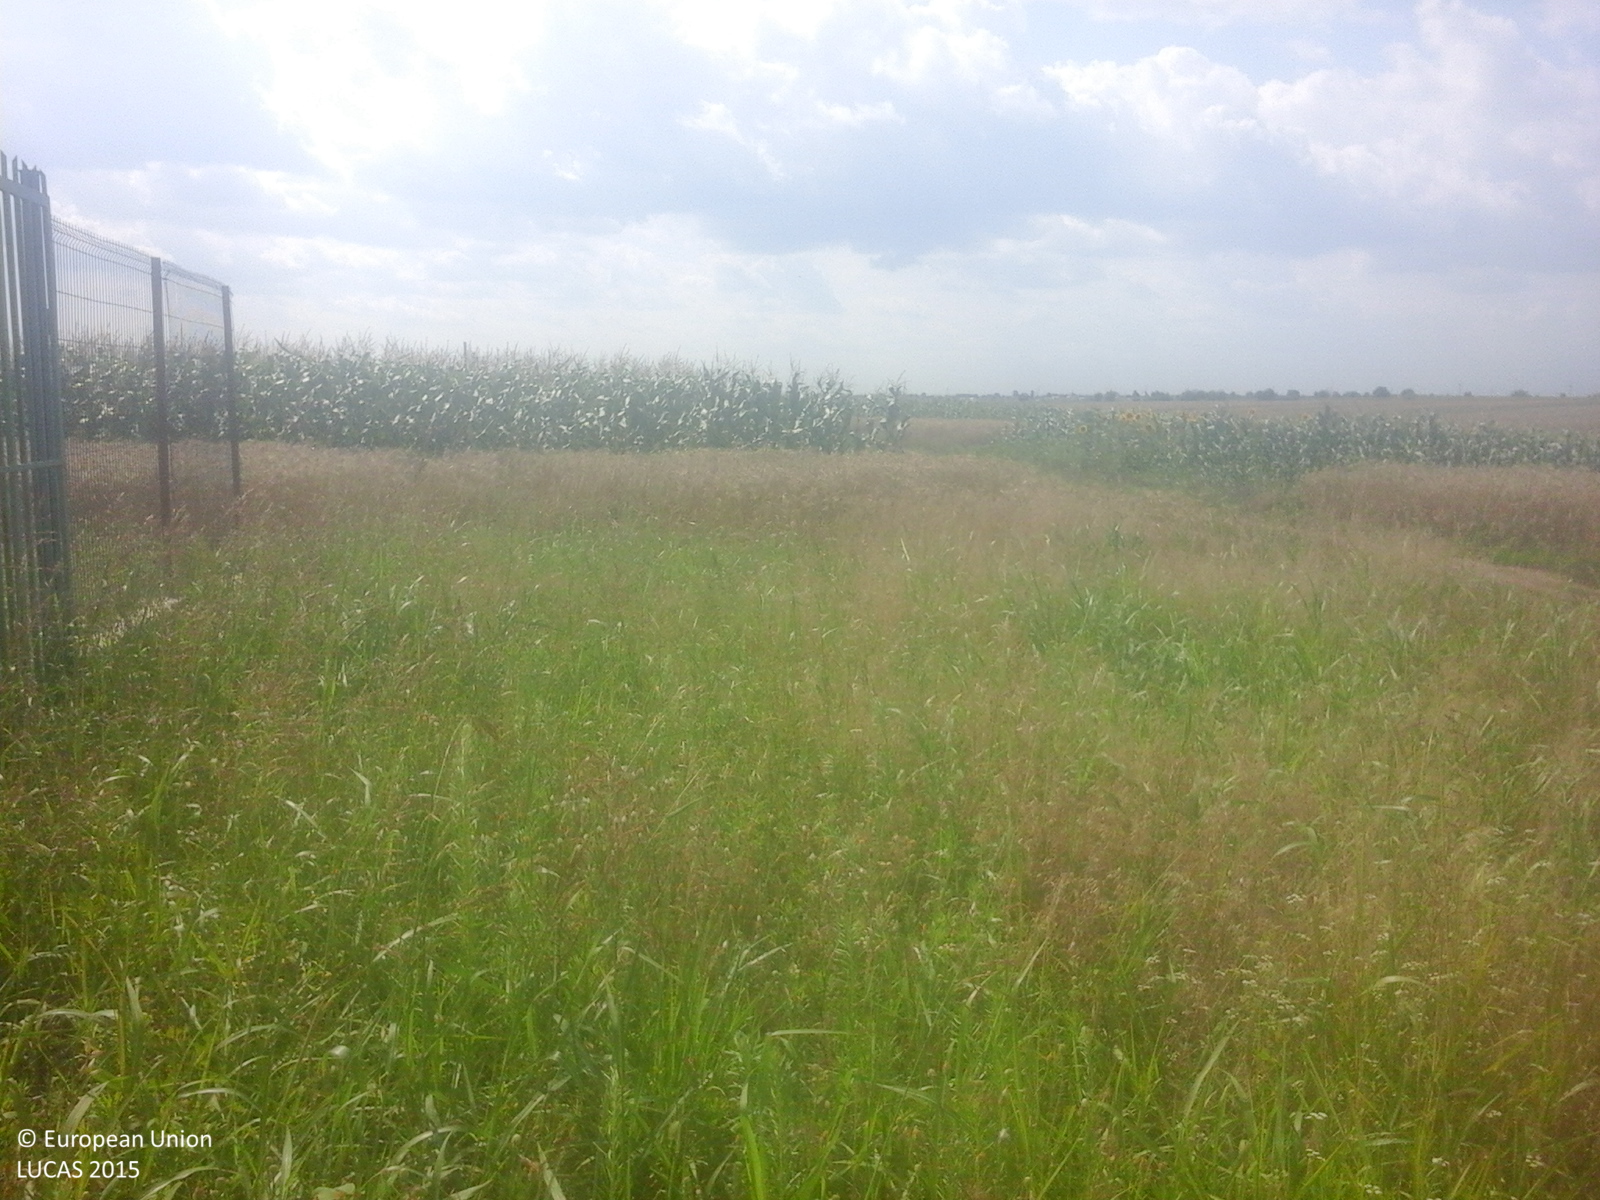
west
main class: Grassland
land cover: Grassland without tree/shrub cover
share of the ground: > 75 %
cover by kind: herbaceous plants 100 %
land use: Agriculture (excluding fallow land and kitchen gardens)
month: July
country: RO
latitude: 43.7777
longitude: 24.5397
